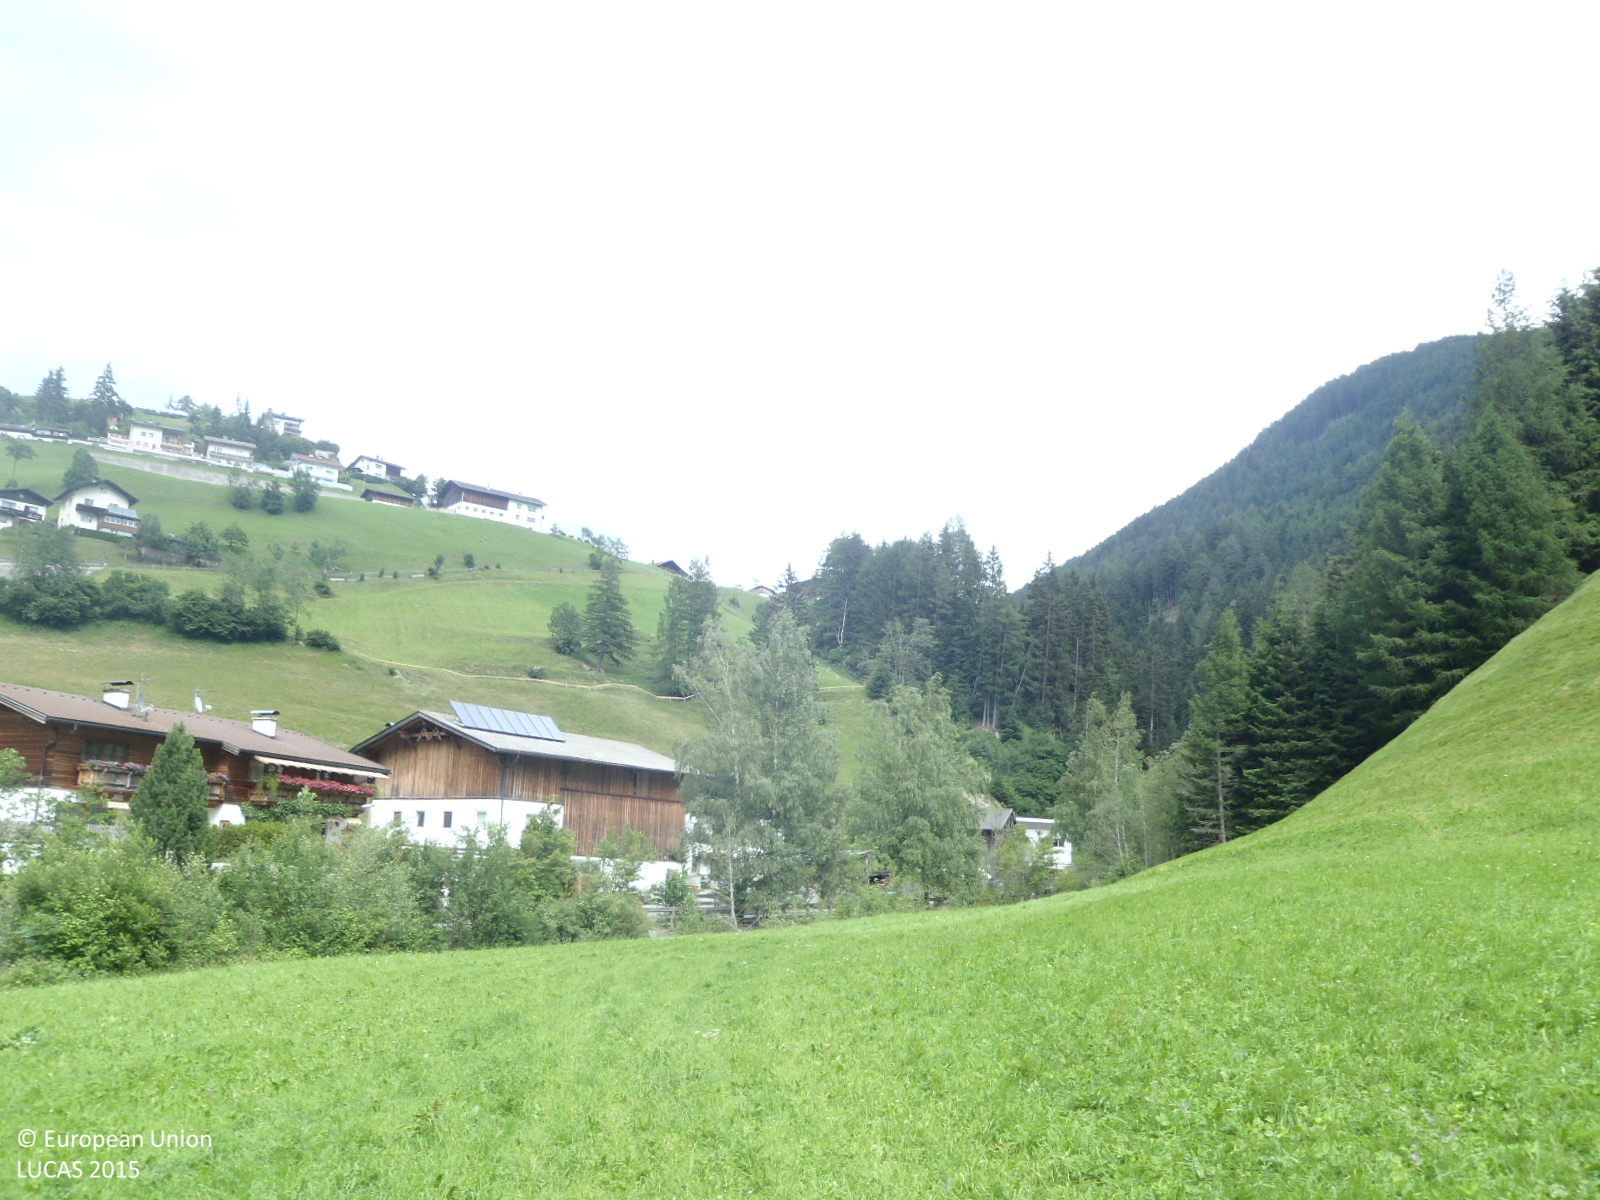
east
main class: Grassland
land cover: Grassland without tree/shrub cover
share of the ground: > 75 %
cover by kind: herbaceous plants 100 %
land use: Agriculture (excluding fallow land and kitchen gardens)
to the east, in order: Grassland without tree/shrub cover; Shrubland without tree cover; Grass margins; Inland fresh running water; Lines of trees; Artificial constructions in urban areas; Grassland without tree/shrub cover; Single bushes/trees; Grassland without tree/shrub cover; Fences; Other mixed woodland
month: June
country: AT
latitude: 47.1157
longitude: 11.4615
